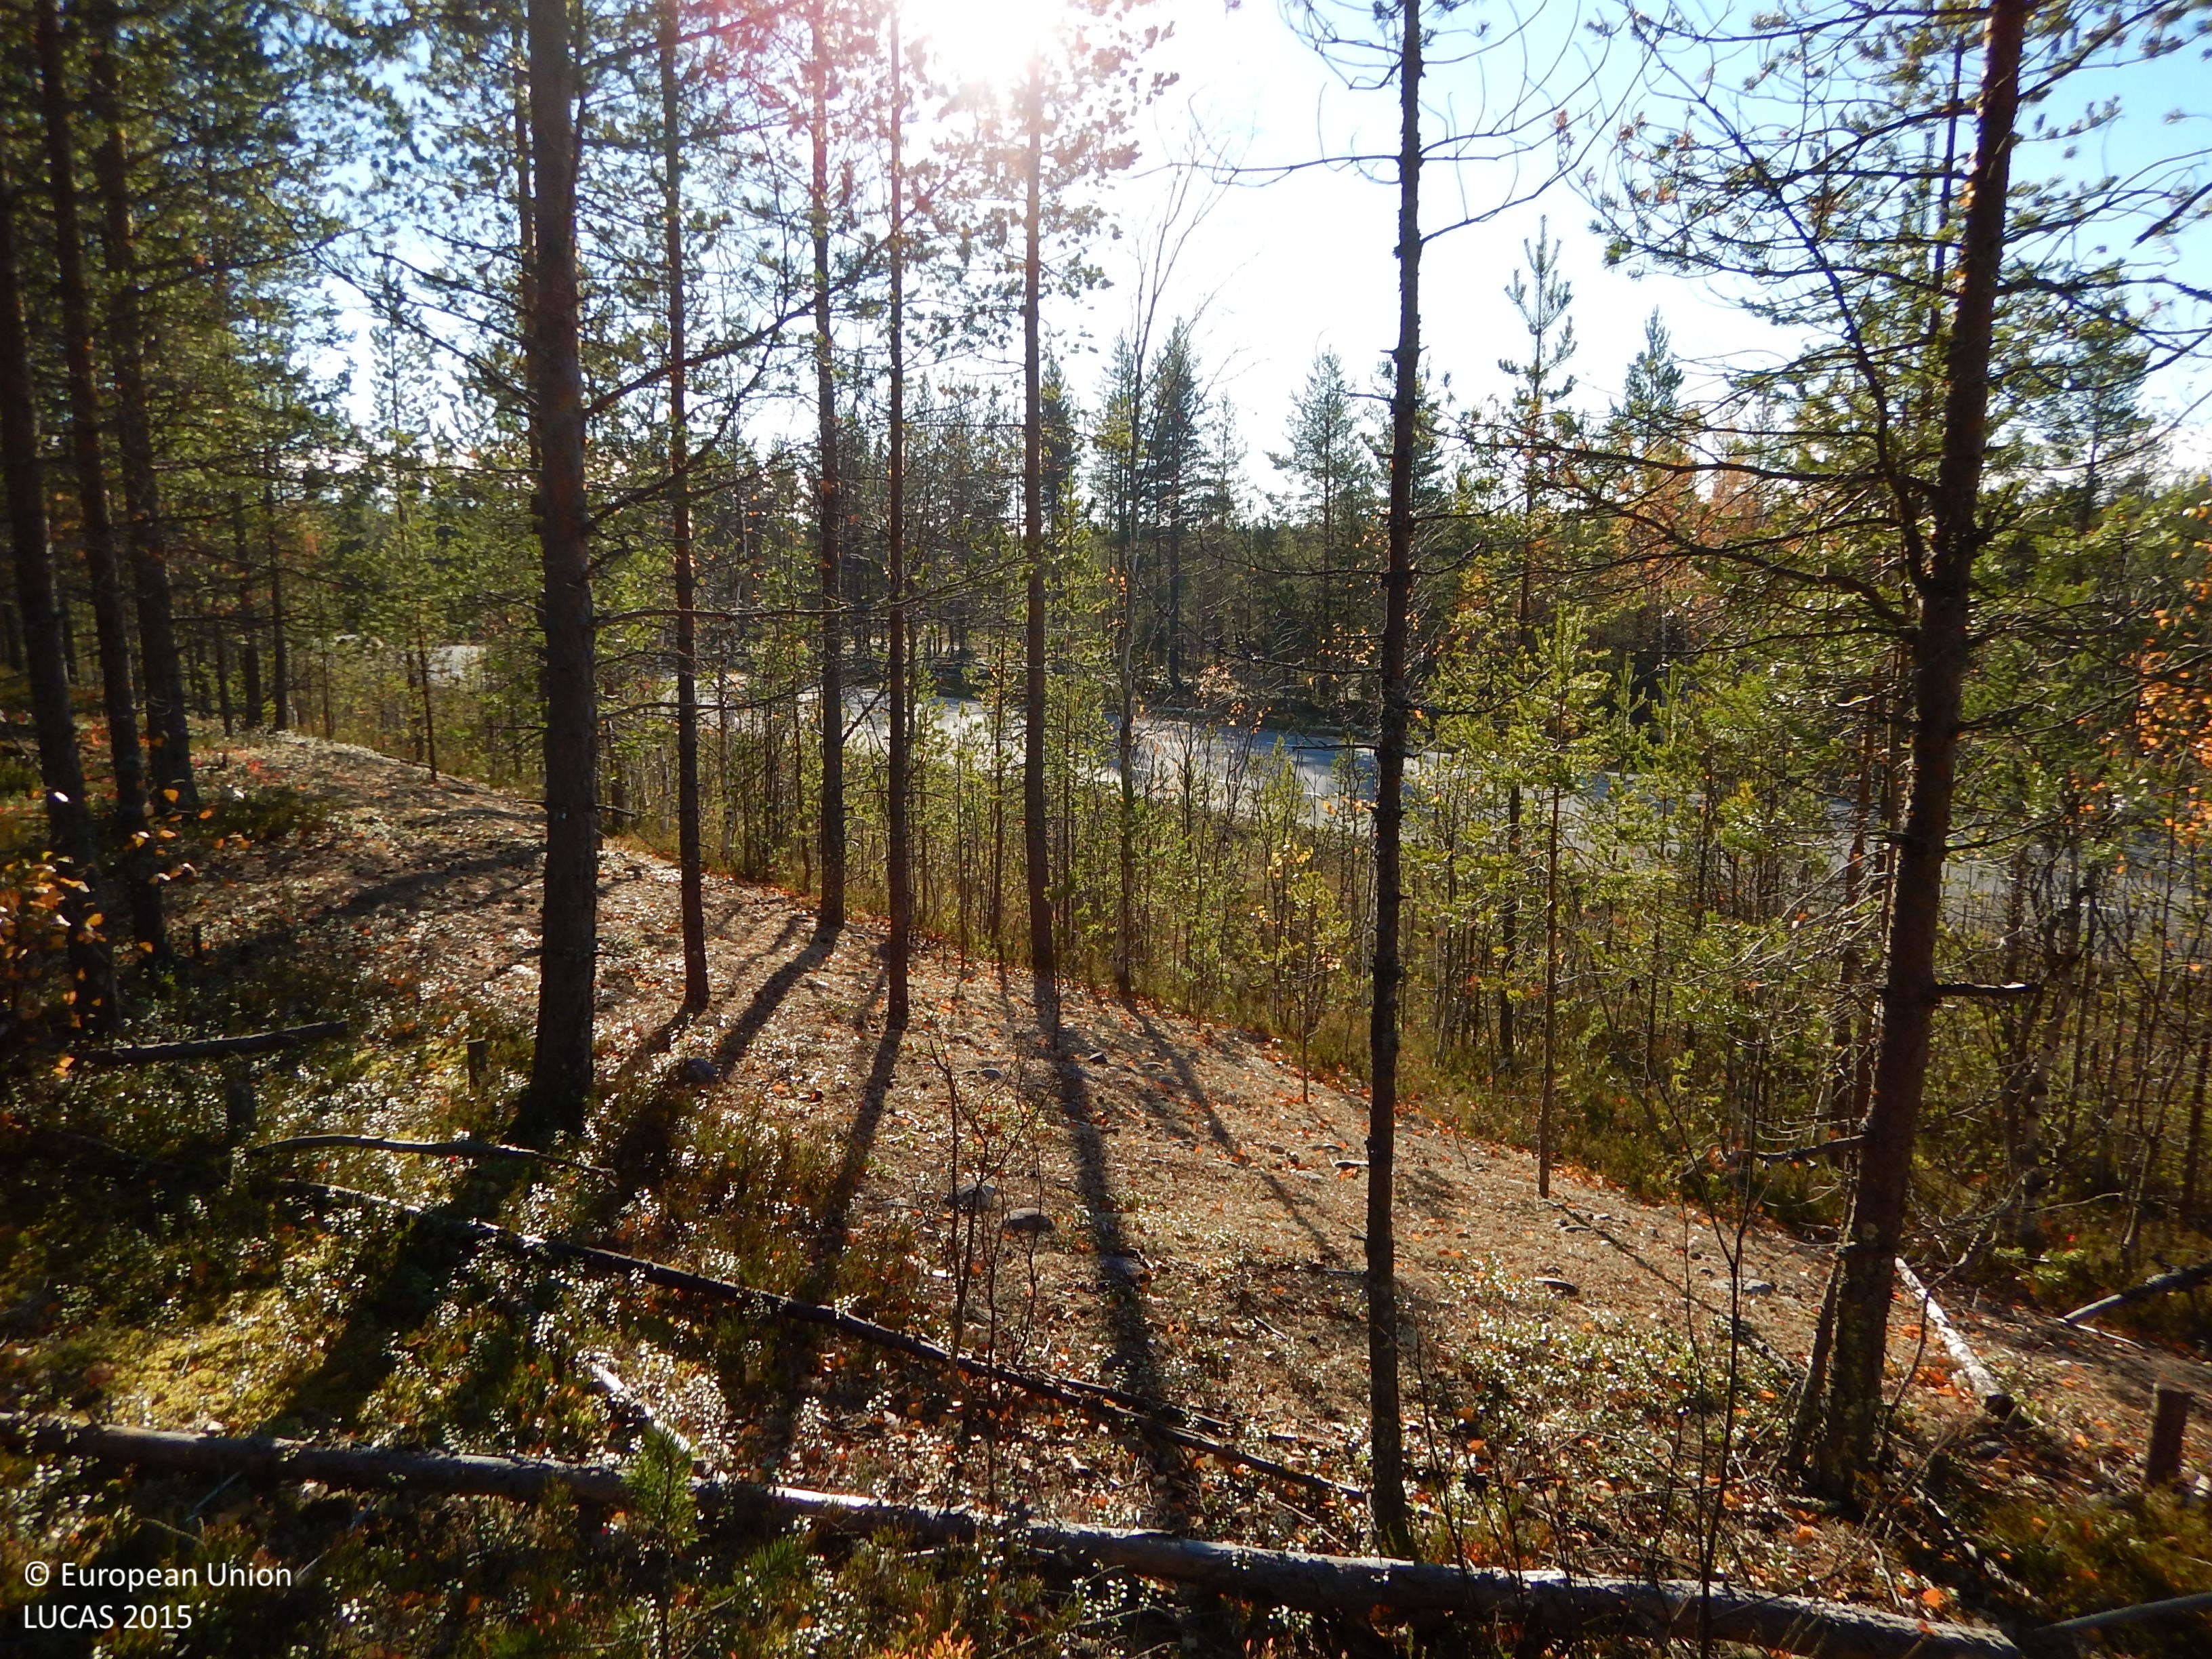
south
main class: Woodland
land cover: Pine dominated coniferous woodland
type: boreal forest
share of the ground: 50 - 75 %
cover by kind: coniferous forest trees 60 %, shrubs 20 %, lichens and mosses 20 %
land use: Forestry
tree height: > 5 m
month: October
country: SE
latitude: 65.0861
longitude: 21.1025
